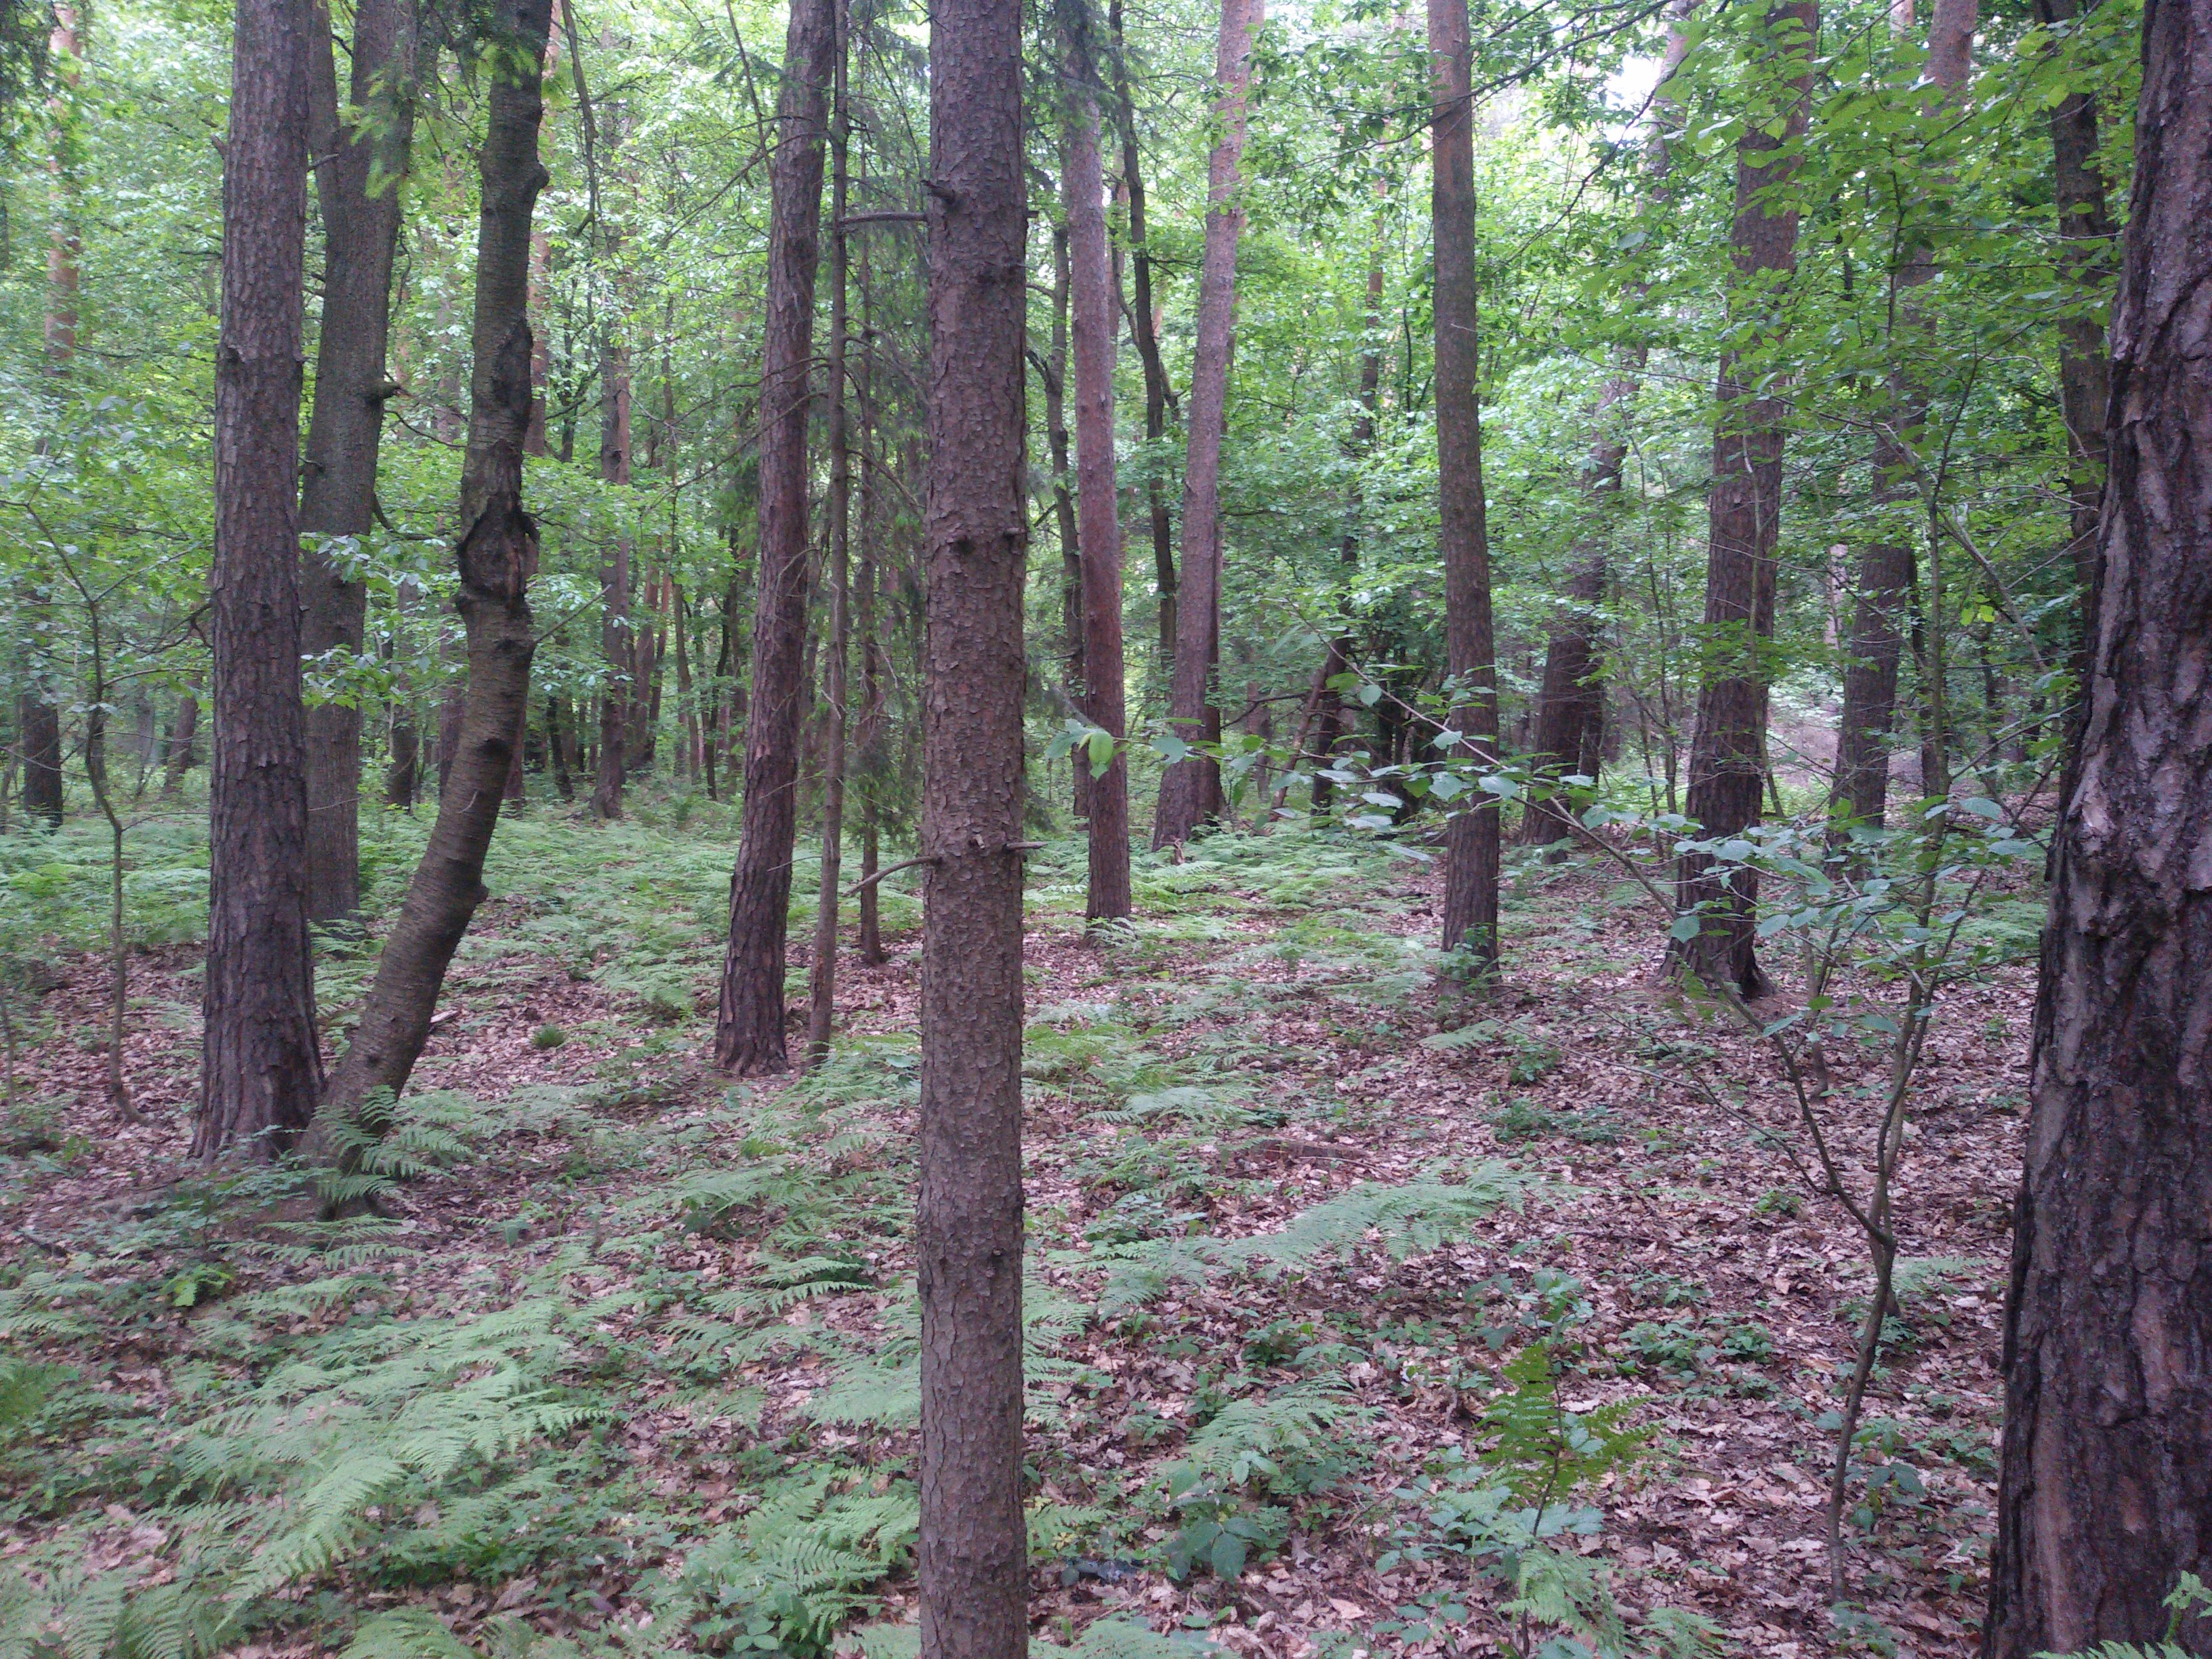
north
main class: Woodland
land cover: Pine dominated mixed woodland
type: hemiboreal forest and nemoral coniferous forest and mixed broadleaved-coniferous forest
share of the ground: > 75 %
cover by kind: coniferous forest trees 60 %, broadleaved forest trees 30 %, herbaceous plants 5 %, lichens and mosses 5 %
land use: Forestry
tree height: > 5 m
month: May
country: PL
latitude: 50.5705
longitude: 17.1978
